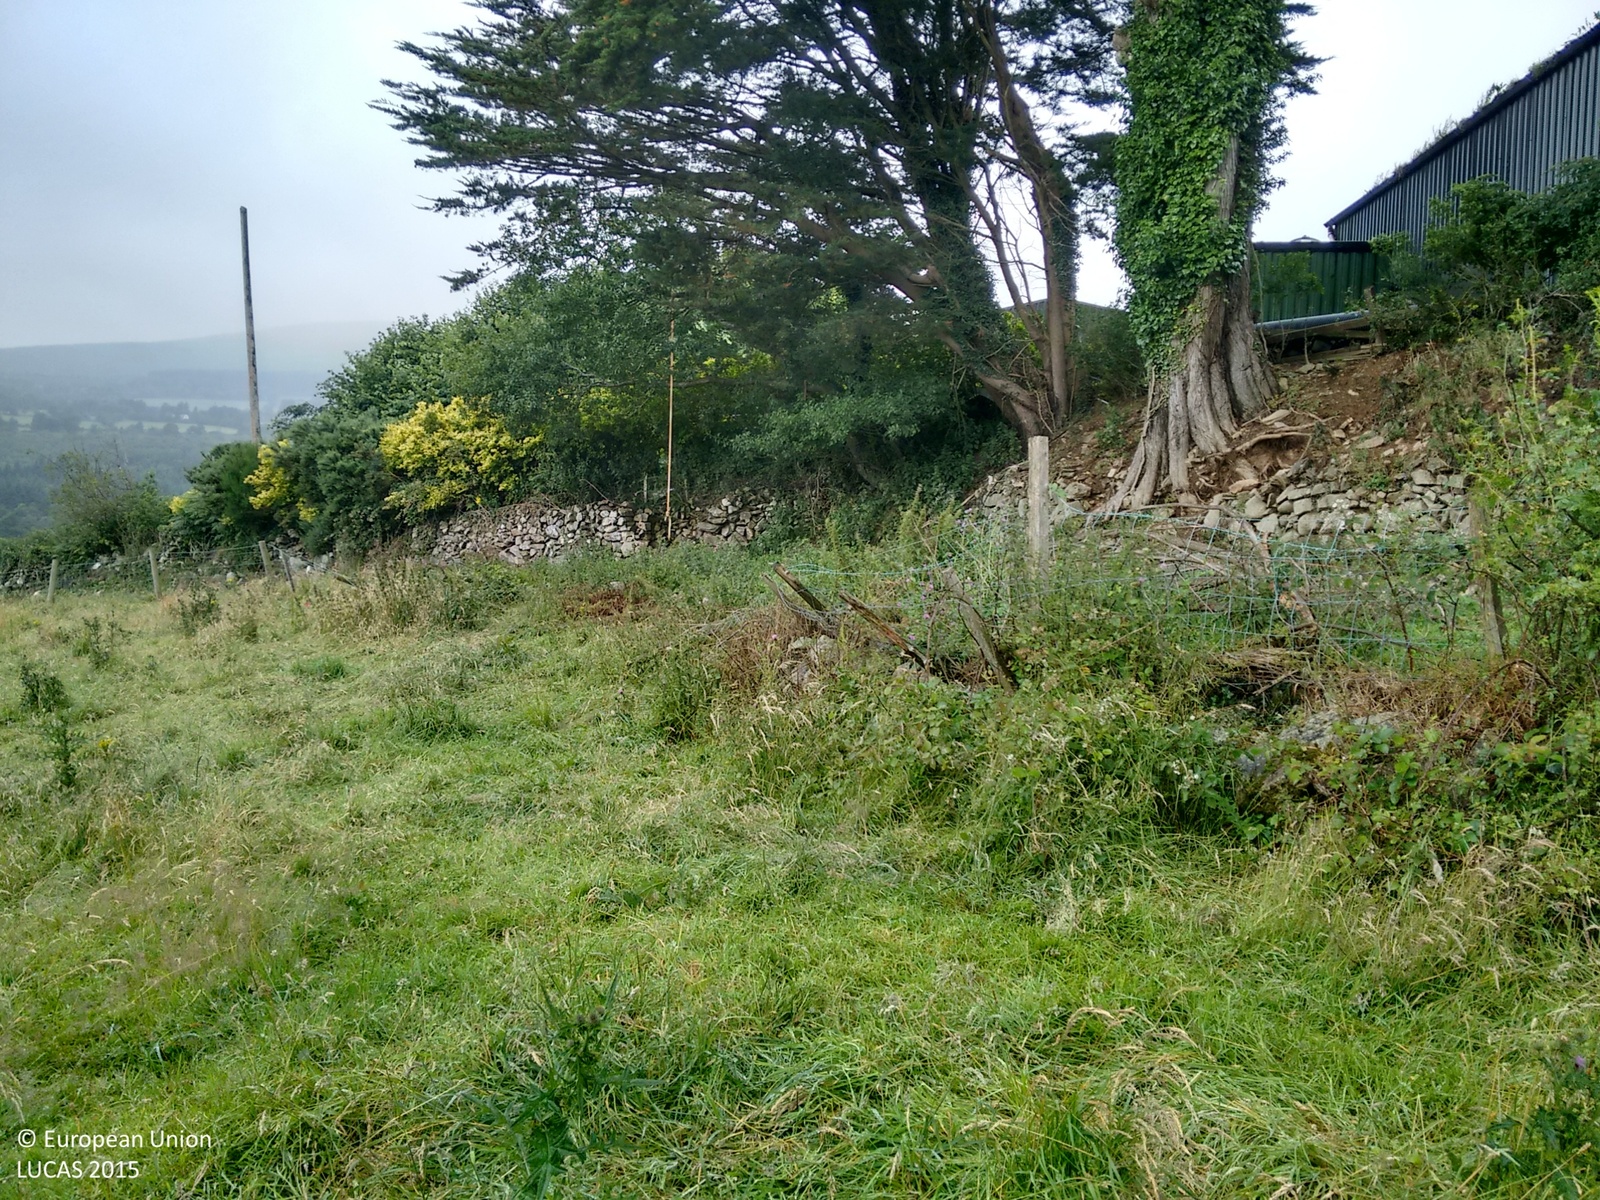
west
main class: Grassland
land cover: Grassland without tree/shrub cover
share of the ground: > 75 %
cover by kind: herbaceous plants 100 %
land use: Agriculture (excluding fallow land and kitchen gardens)
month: July
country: IE
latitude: 52.9305
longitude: -6.2923
